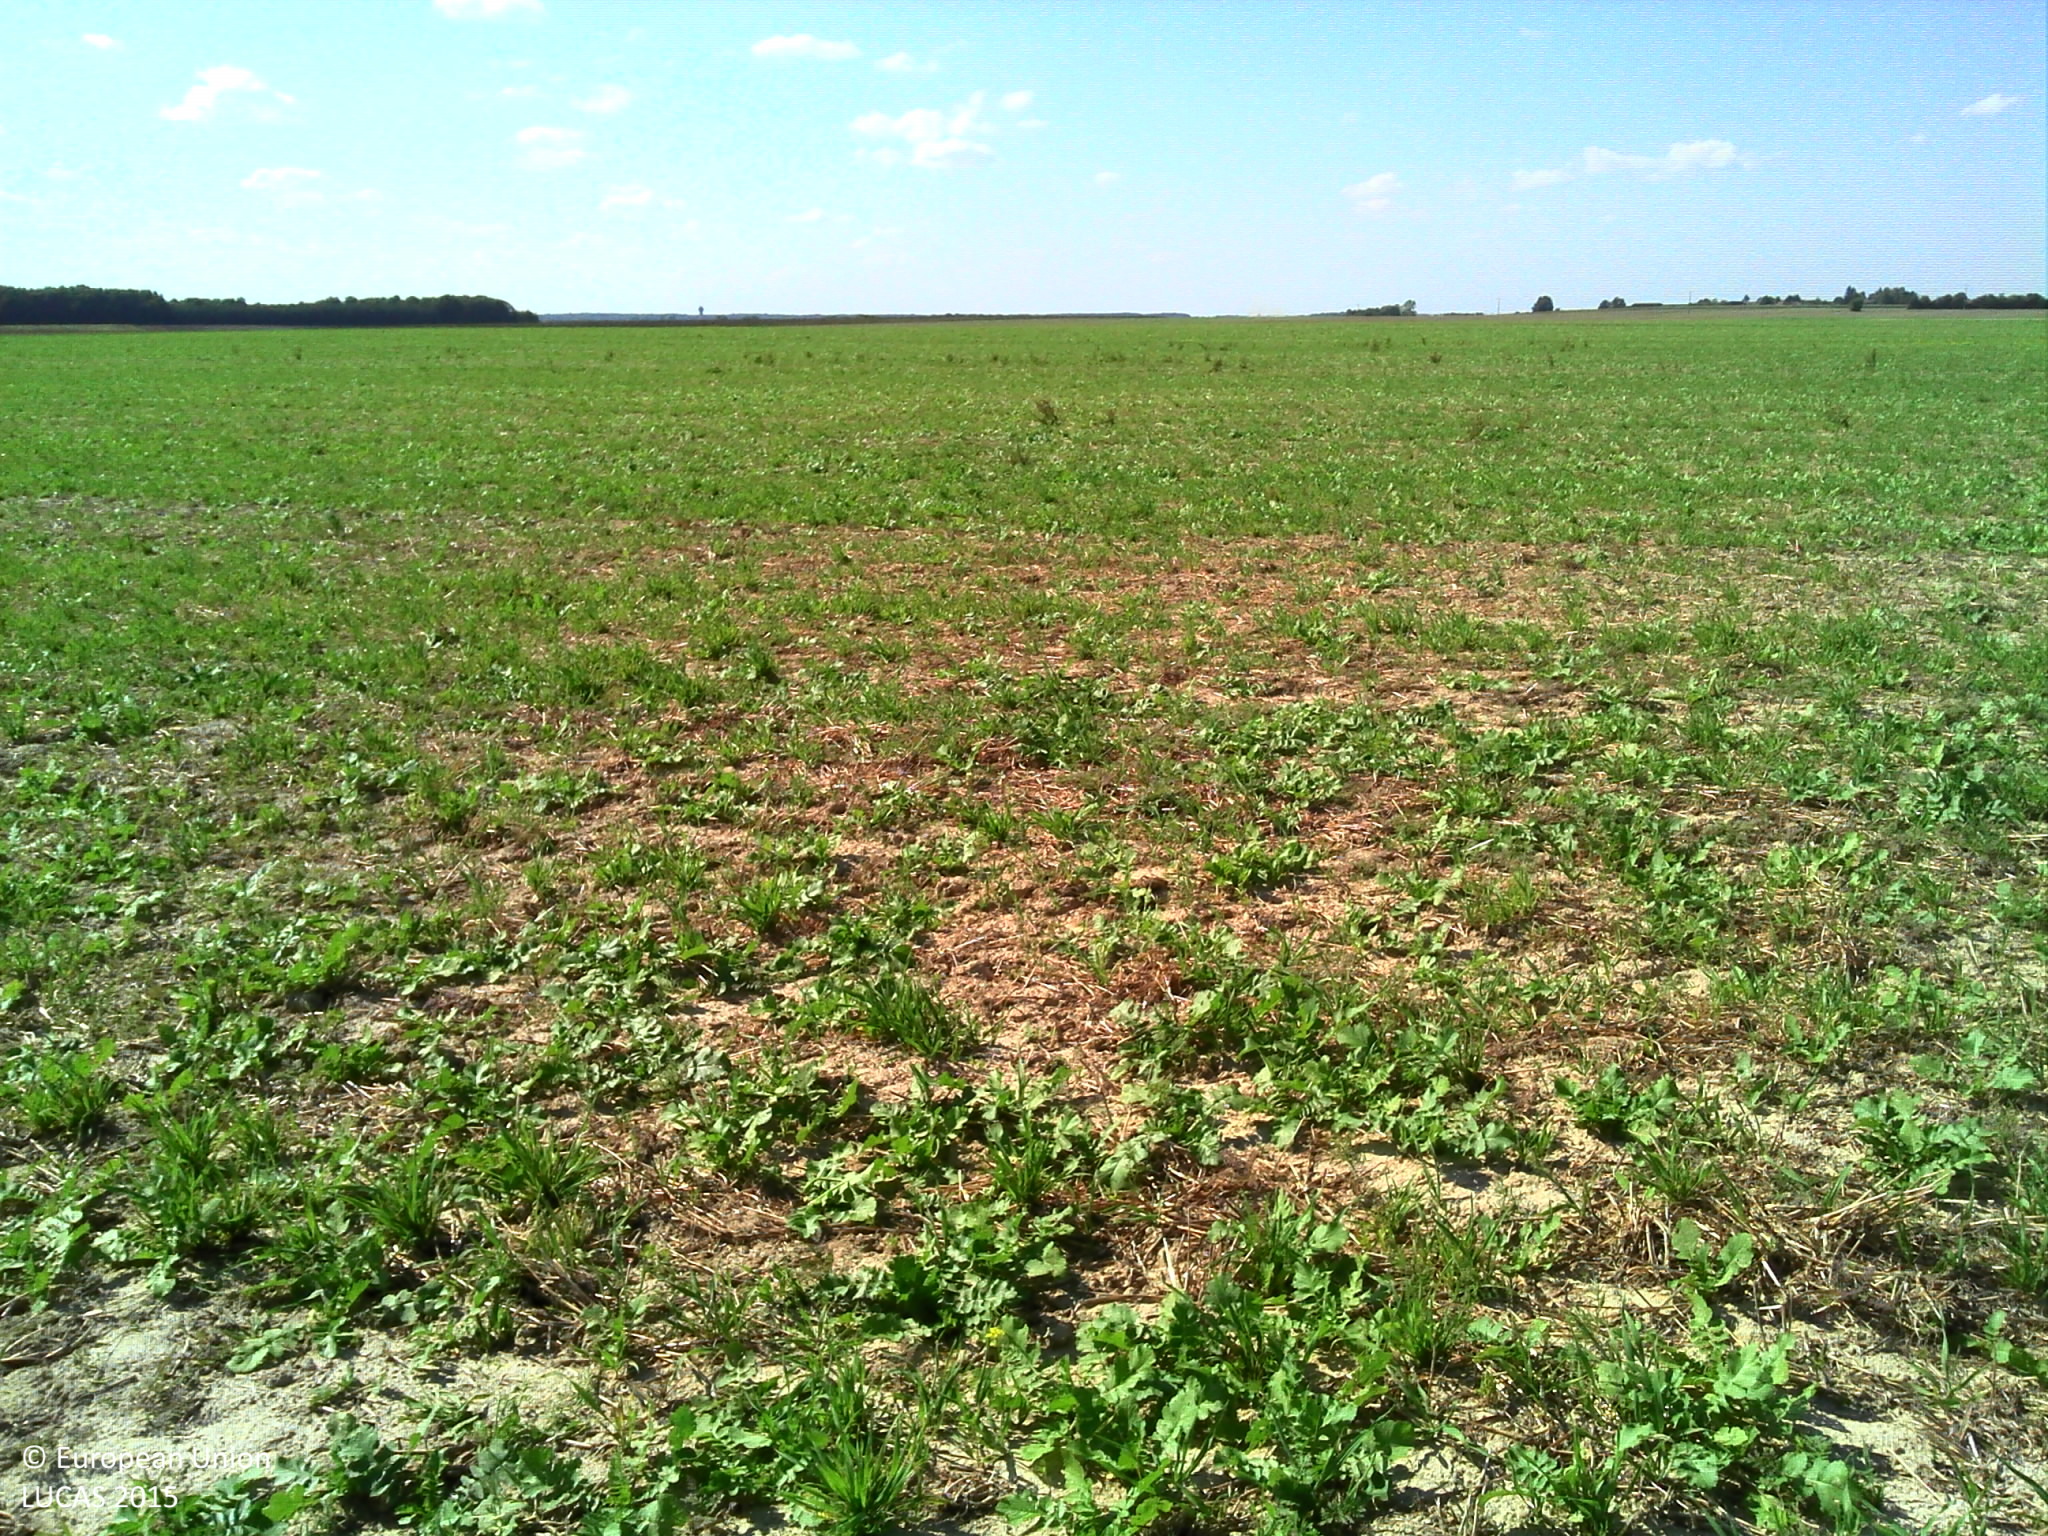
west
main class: Cropland
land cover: Other root crops
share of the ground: < 10 %
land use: Agriculture (excluding fallow land and kitchen gardens)
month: September
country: FR
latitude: 47.1156
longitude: 1.4866
